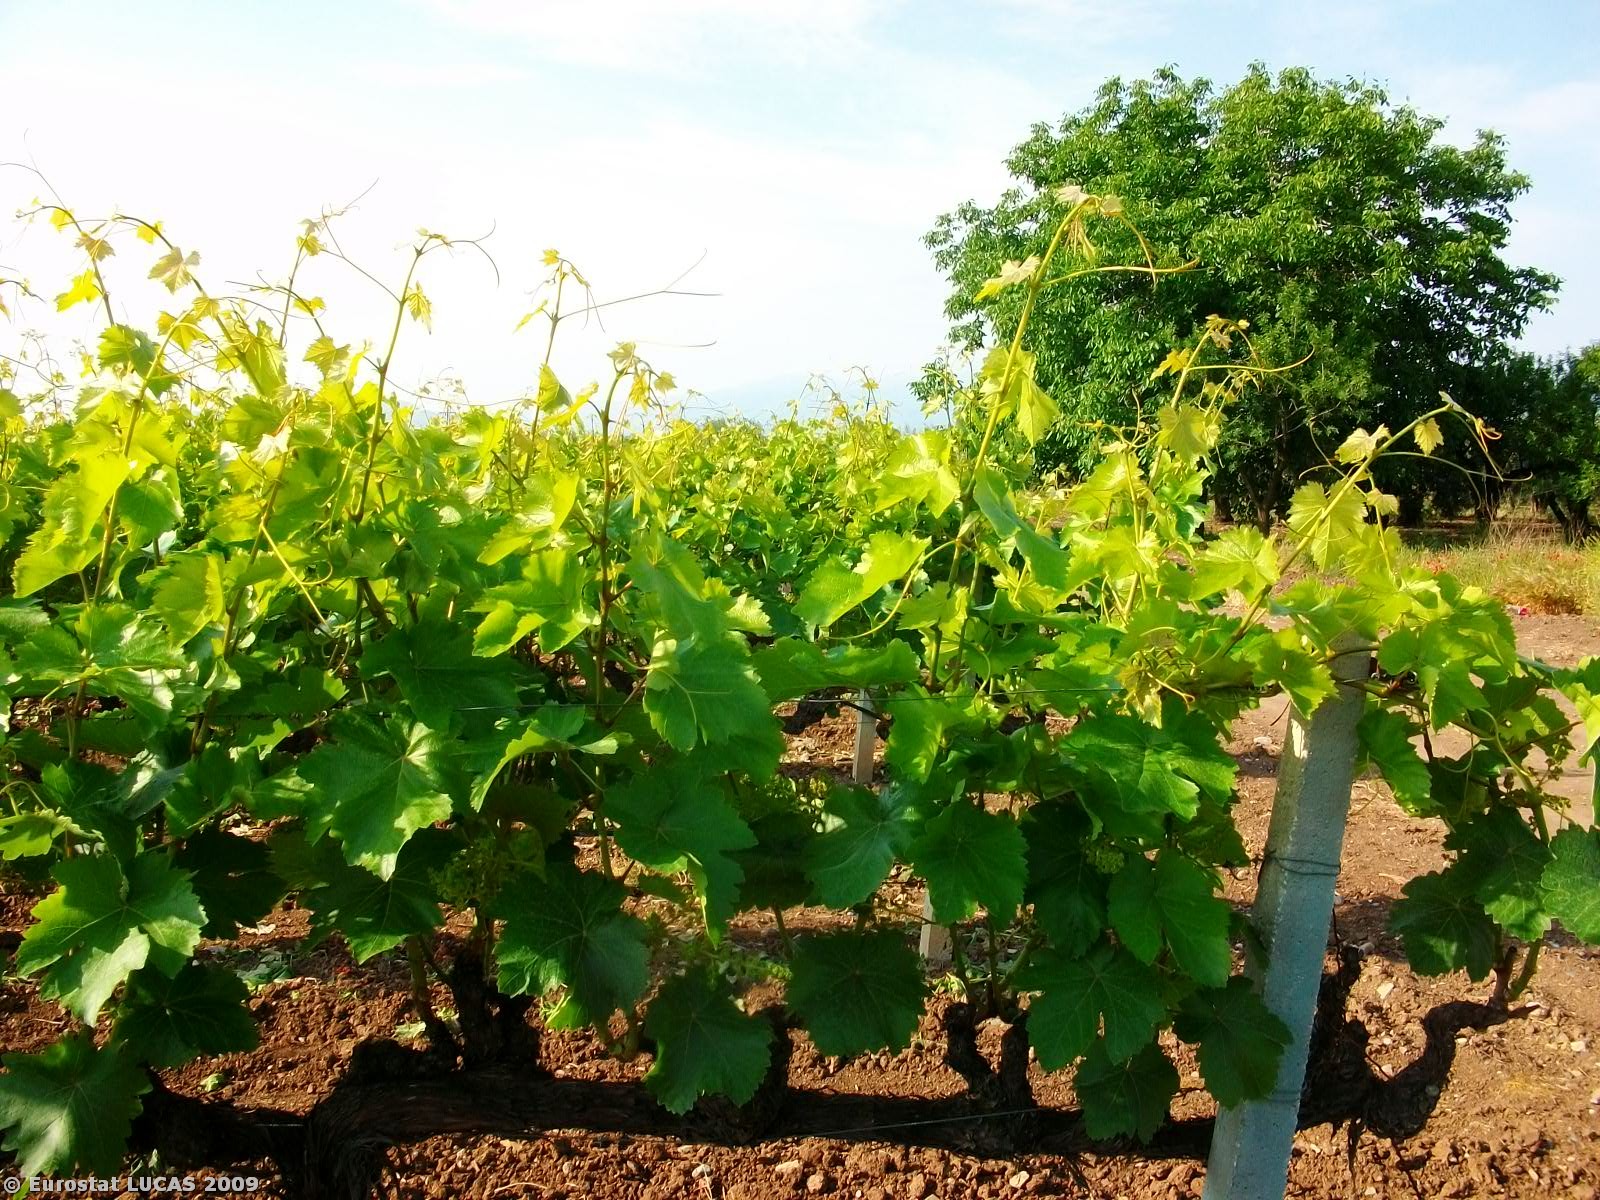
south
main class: Cropland
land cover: Vineyards
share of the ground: 10 - 25 %
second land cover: Bare land
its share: > 75 %
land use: Agriculture (excluding fallow land and kitchen gardens)
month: May
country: GR
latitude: 39.2463
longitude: 22.7686
